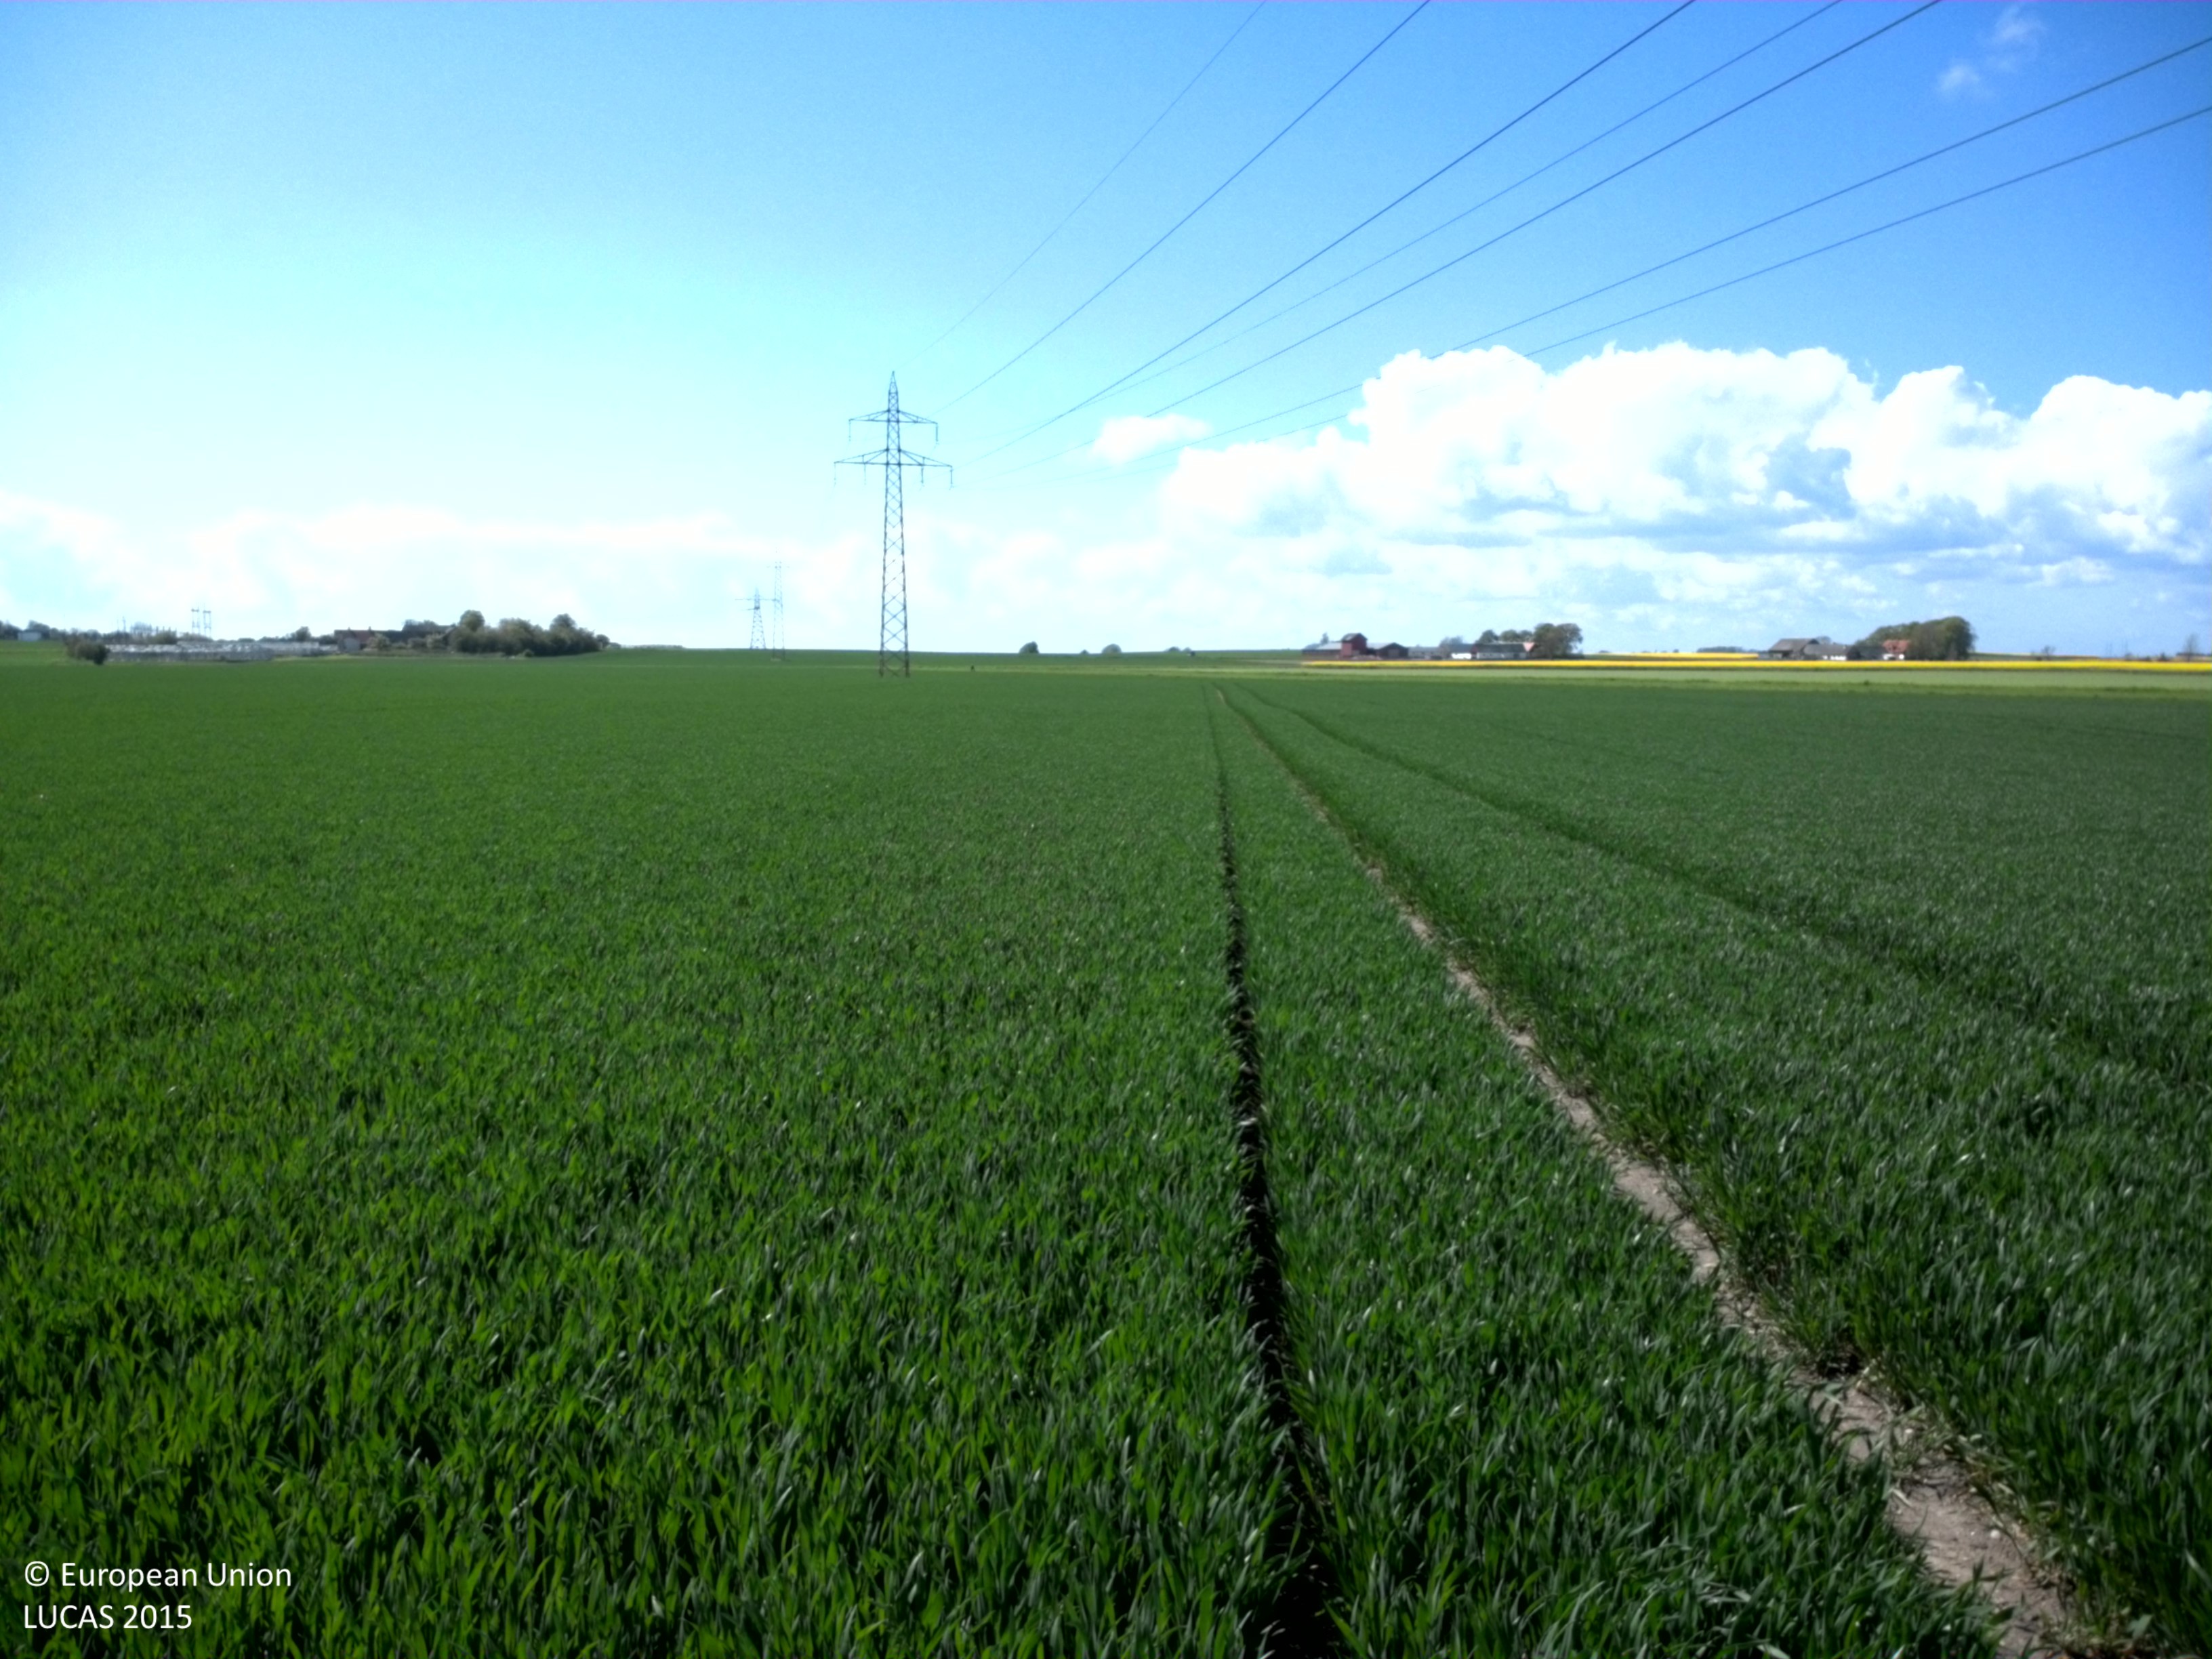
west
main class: Cropland
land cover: Common wheat
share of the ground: > 75 %
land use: Agriculture (excluding fallow land and kitchen gardens)
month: May
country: SE
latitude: 55.4859
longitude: 13.0524
